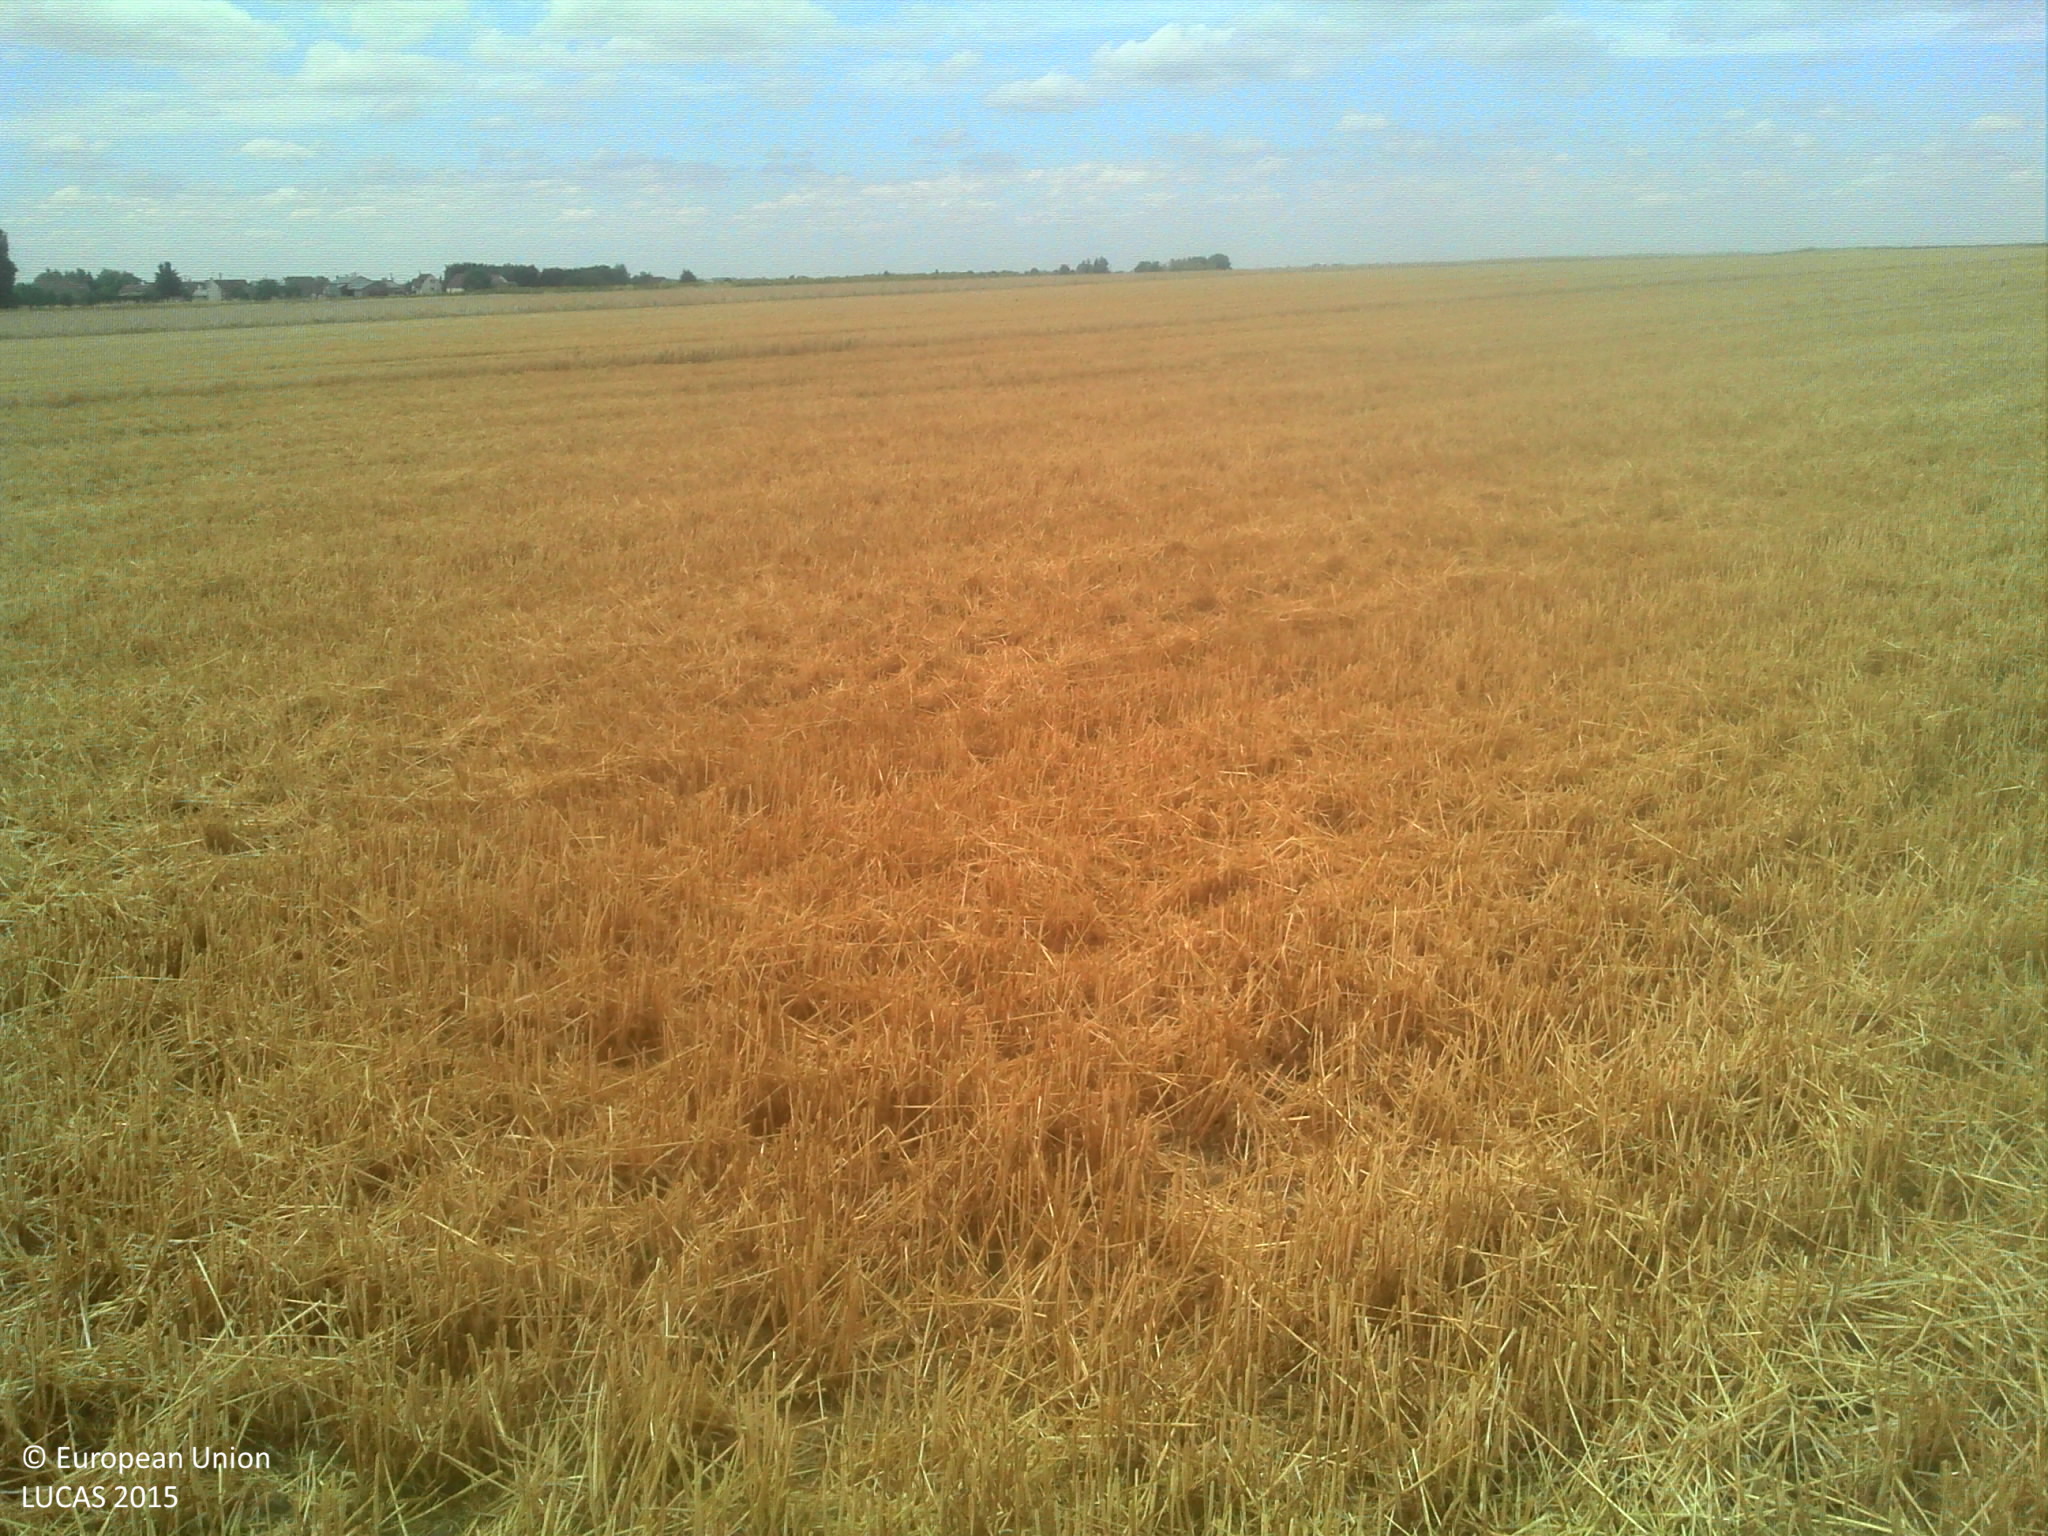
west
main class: Cropland
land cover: Durum wheat
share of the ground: > 75 %
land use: Agriculture (excluding fallow land and kitchen gardens)
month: July
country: FR
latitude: 47.7209
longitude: 1.3592
